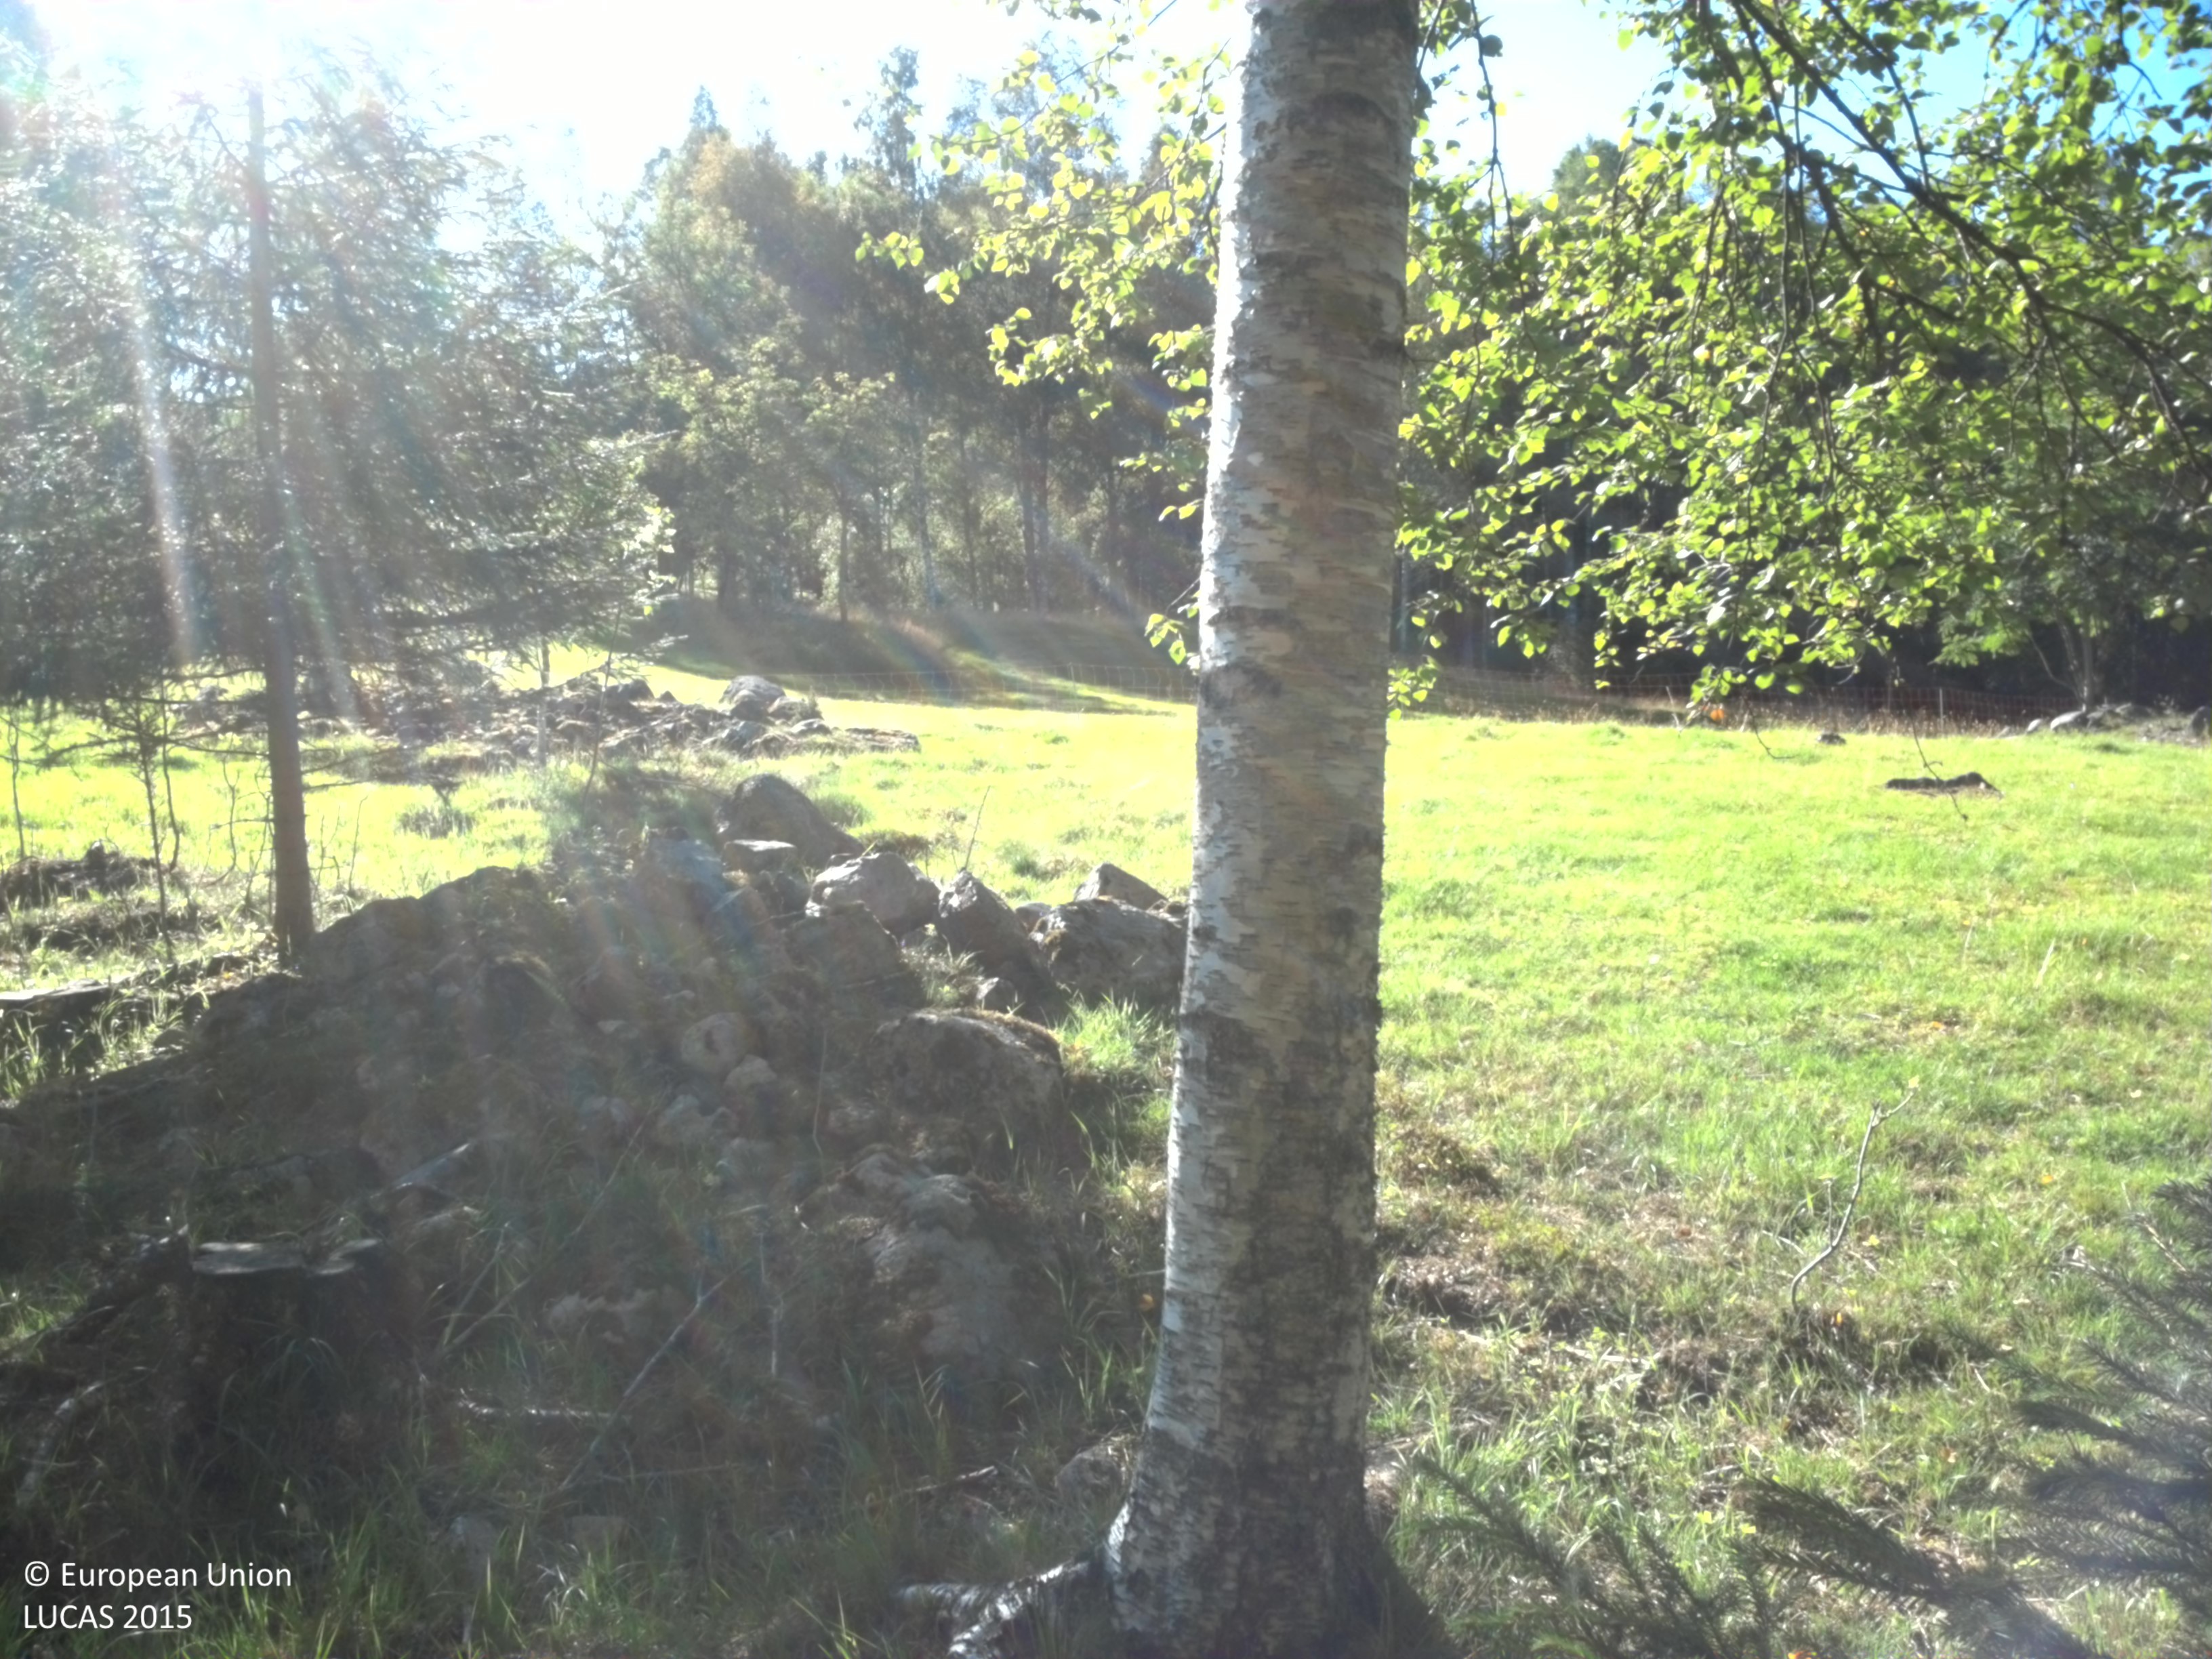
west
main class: Woodland
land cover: Broadleaved woodland
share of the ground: 50 - 75 %
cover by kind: broadleaved forest trees 50 %, herbaceous plants 40 %, coniferous forest trees 10 %
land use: Agriculture (excluding fallow land and kitchen gardens)
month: August
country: SE
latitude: 59.9369
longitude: 14.2314
